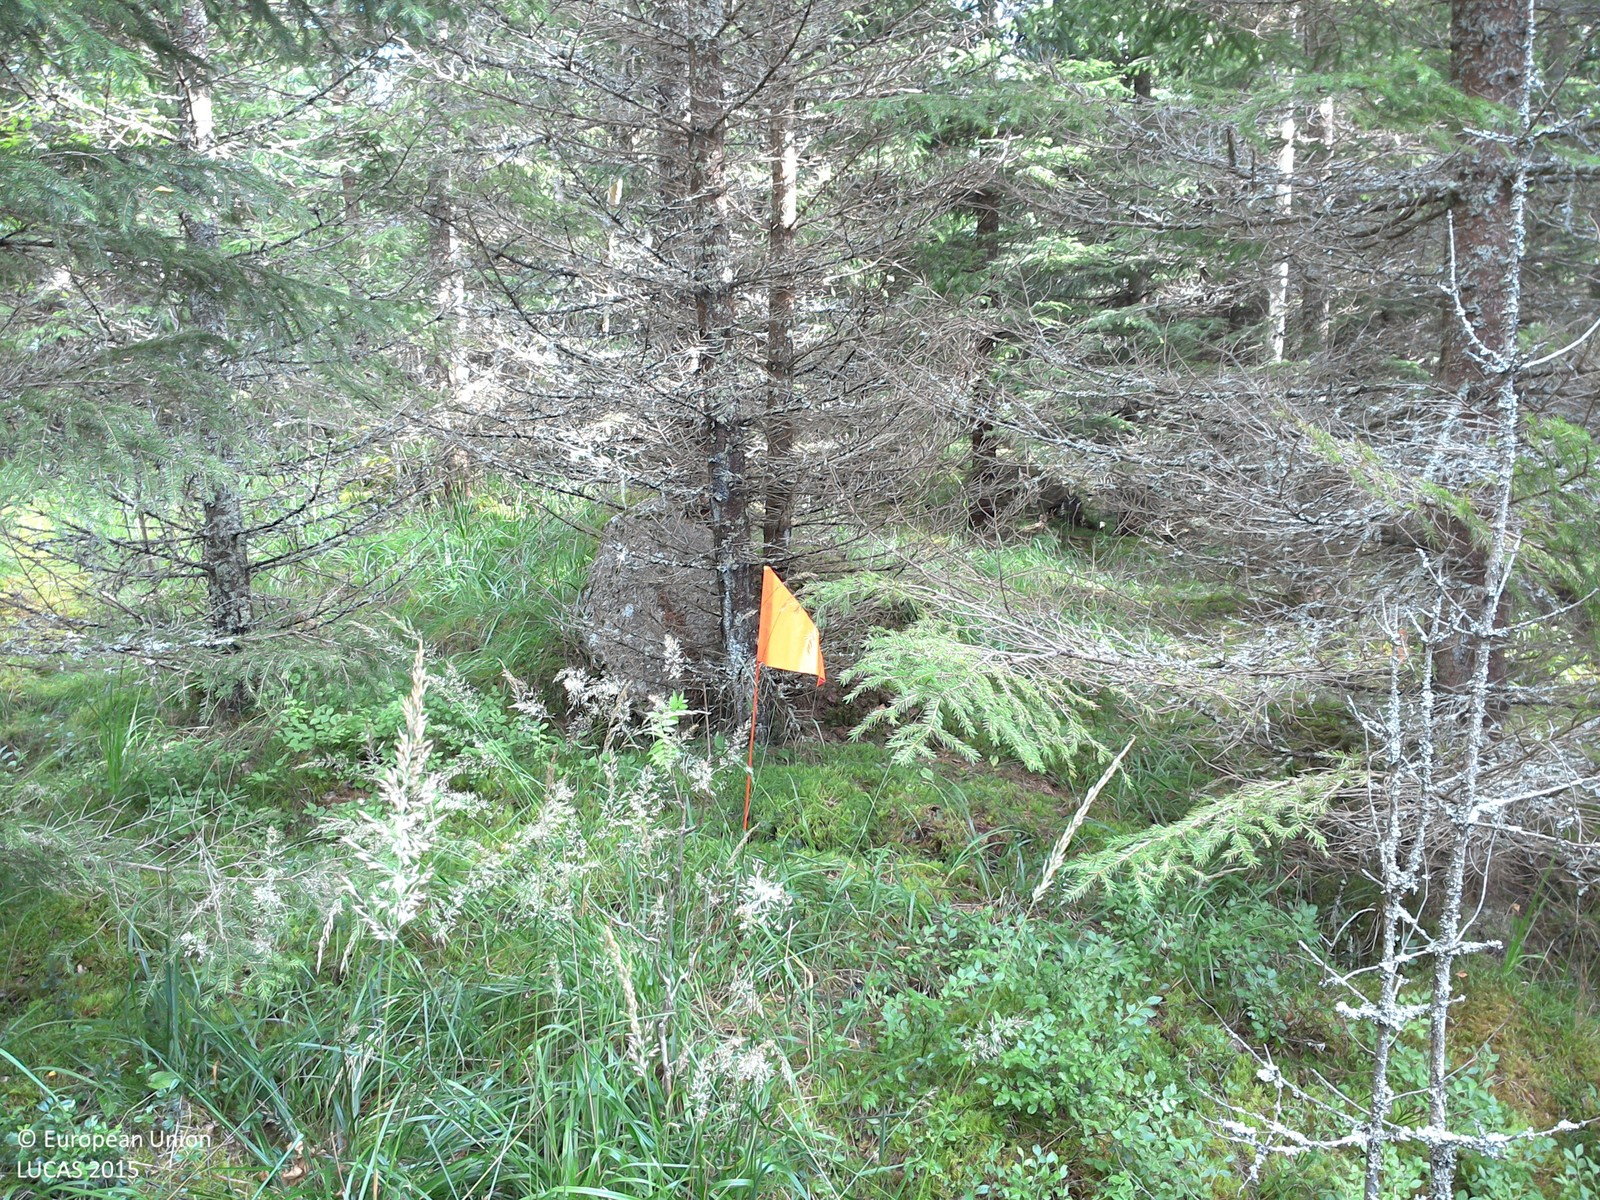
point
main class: Woodland
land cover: Spruce dominated coniferous woodland
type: boreal forest
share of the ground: 50 - 75 %
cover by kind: coniferous forest trees 60 %, lichens and mosses 30 %, herbaceous plants 10 %
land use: Forestry
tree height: > 5 m
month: August
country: SE
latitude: 58.1286
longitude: 15.4117
